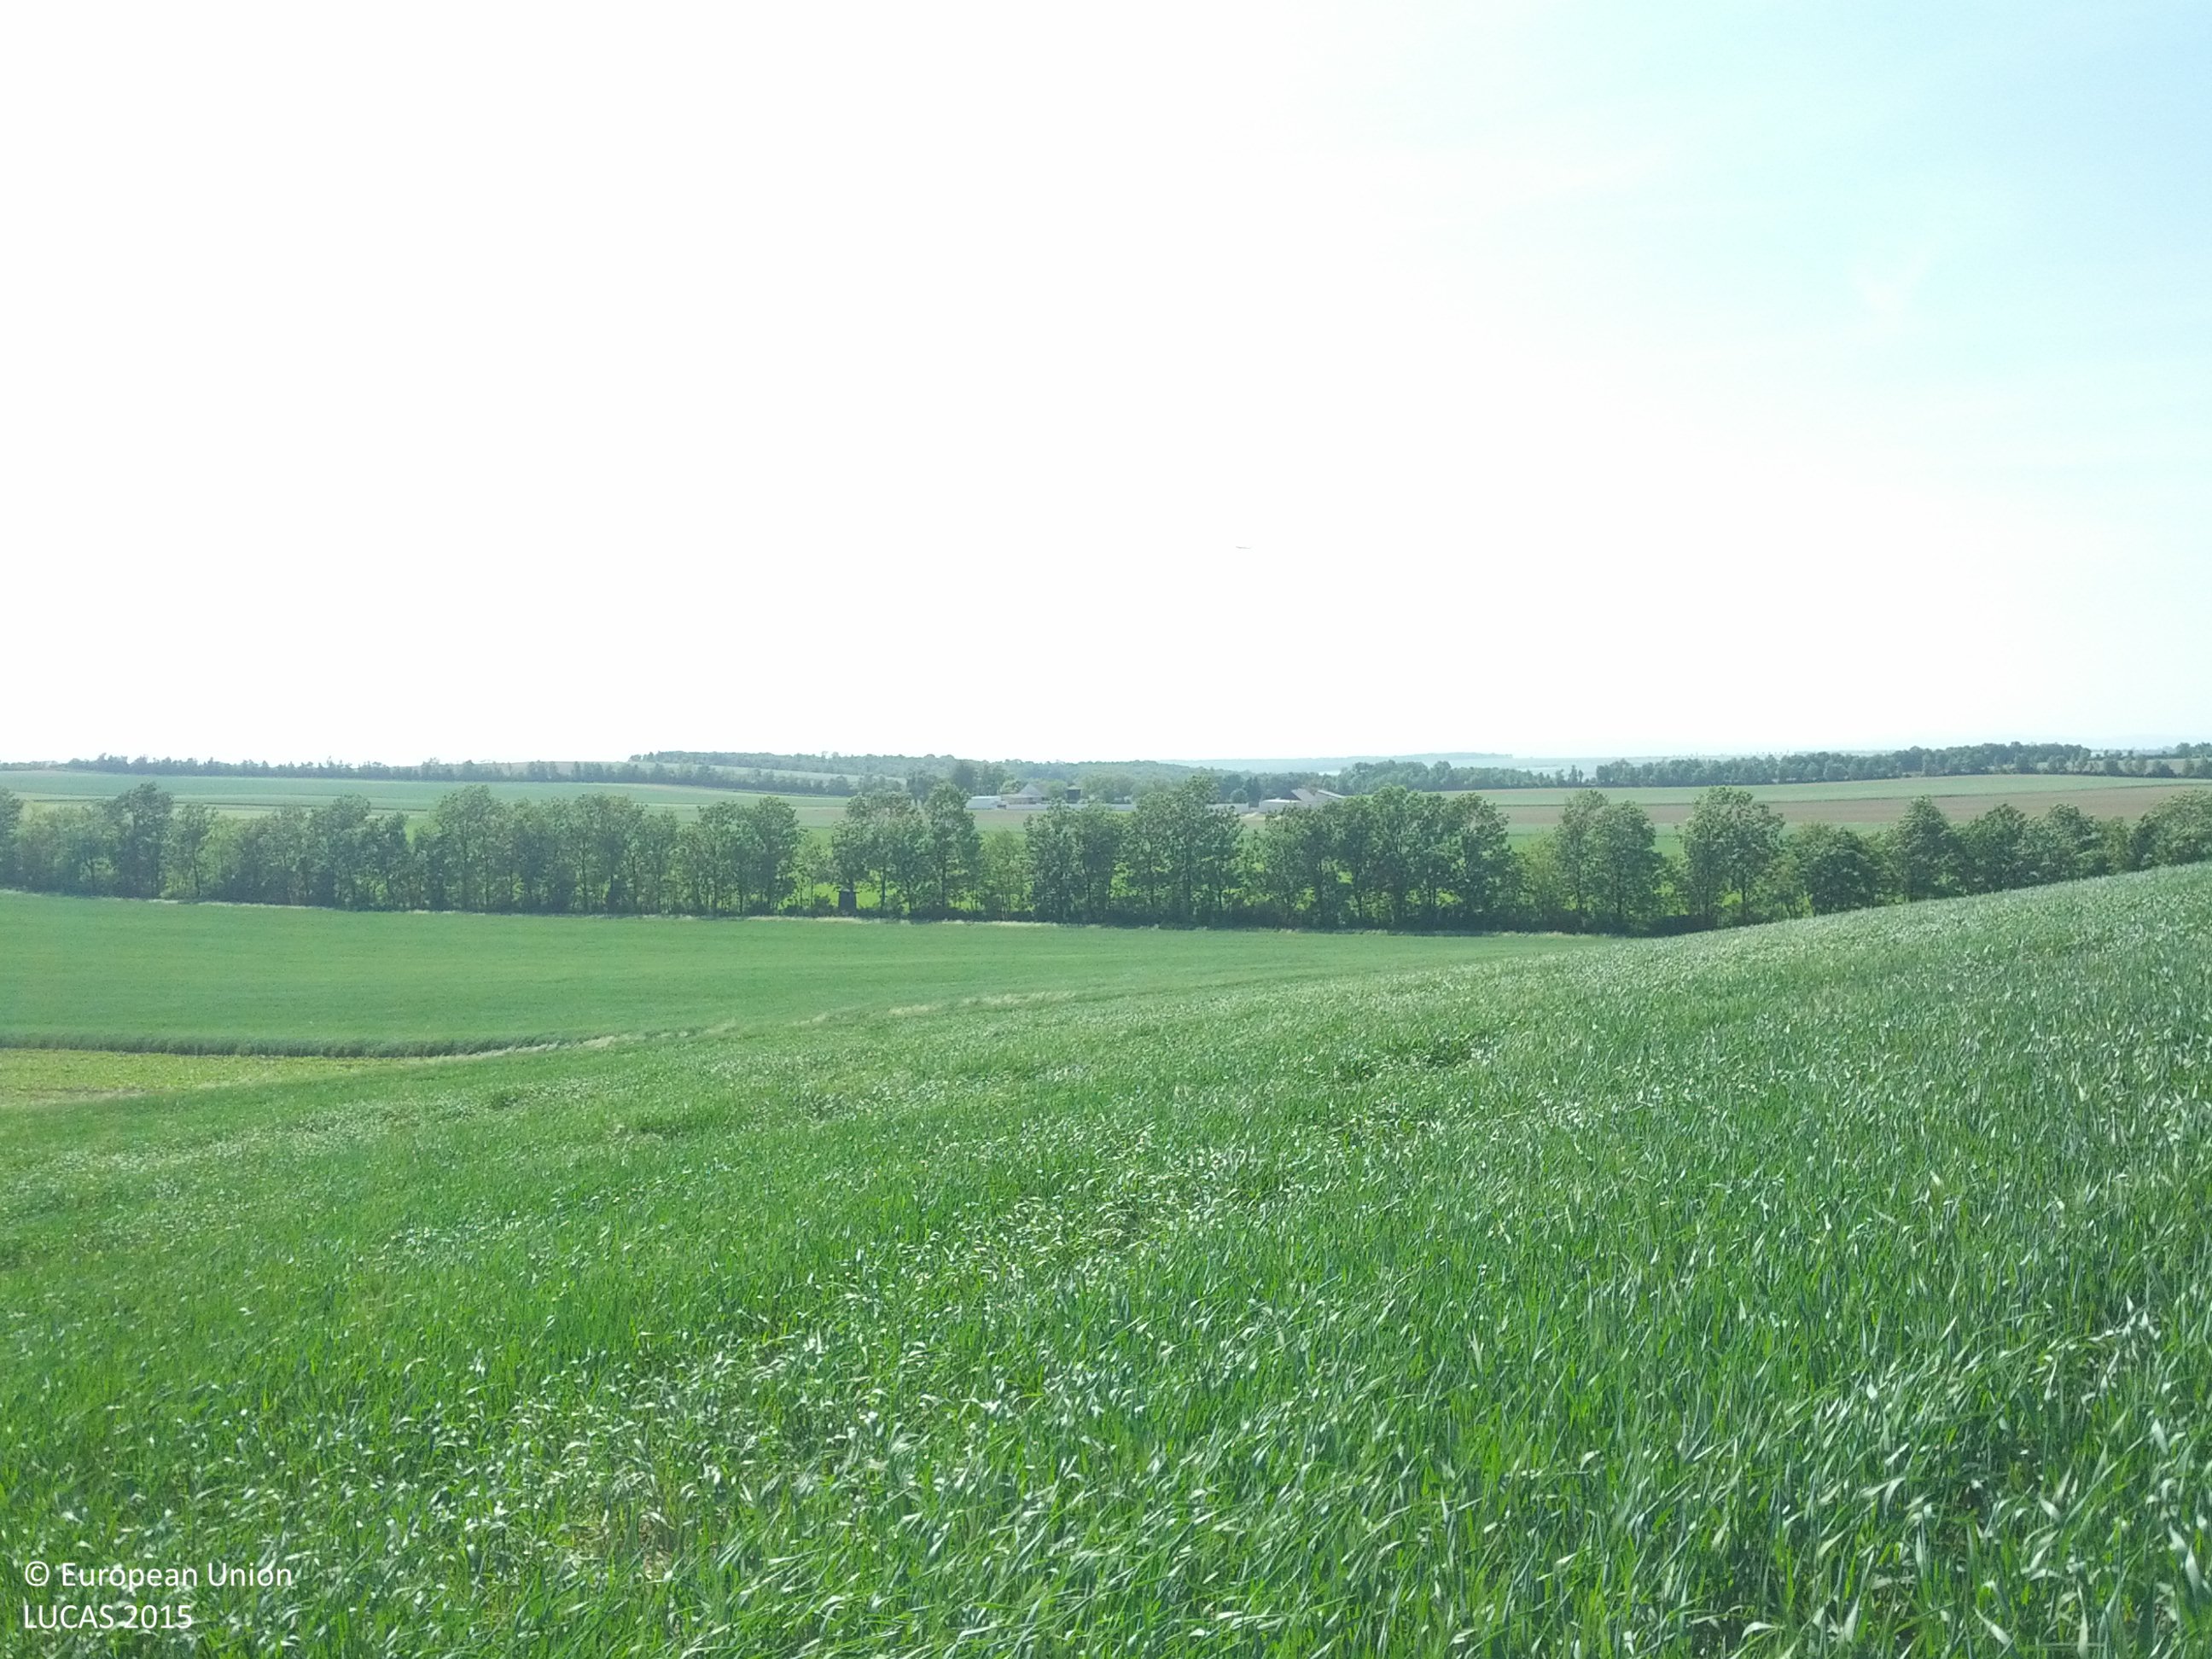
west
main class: Cropland
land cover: Barley
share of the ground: > 75 %
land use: Agriculture (excluding fallow land and kitchen gardens)
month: May
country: AT
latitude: 48.0769
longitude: 16.6499
